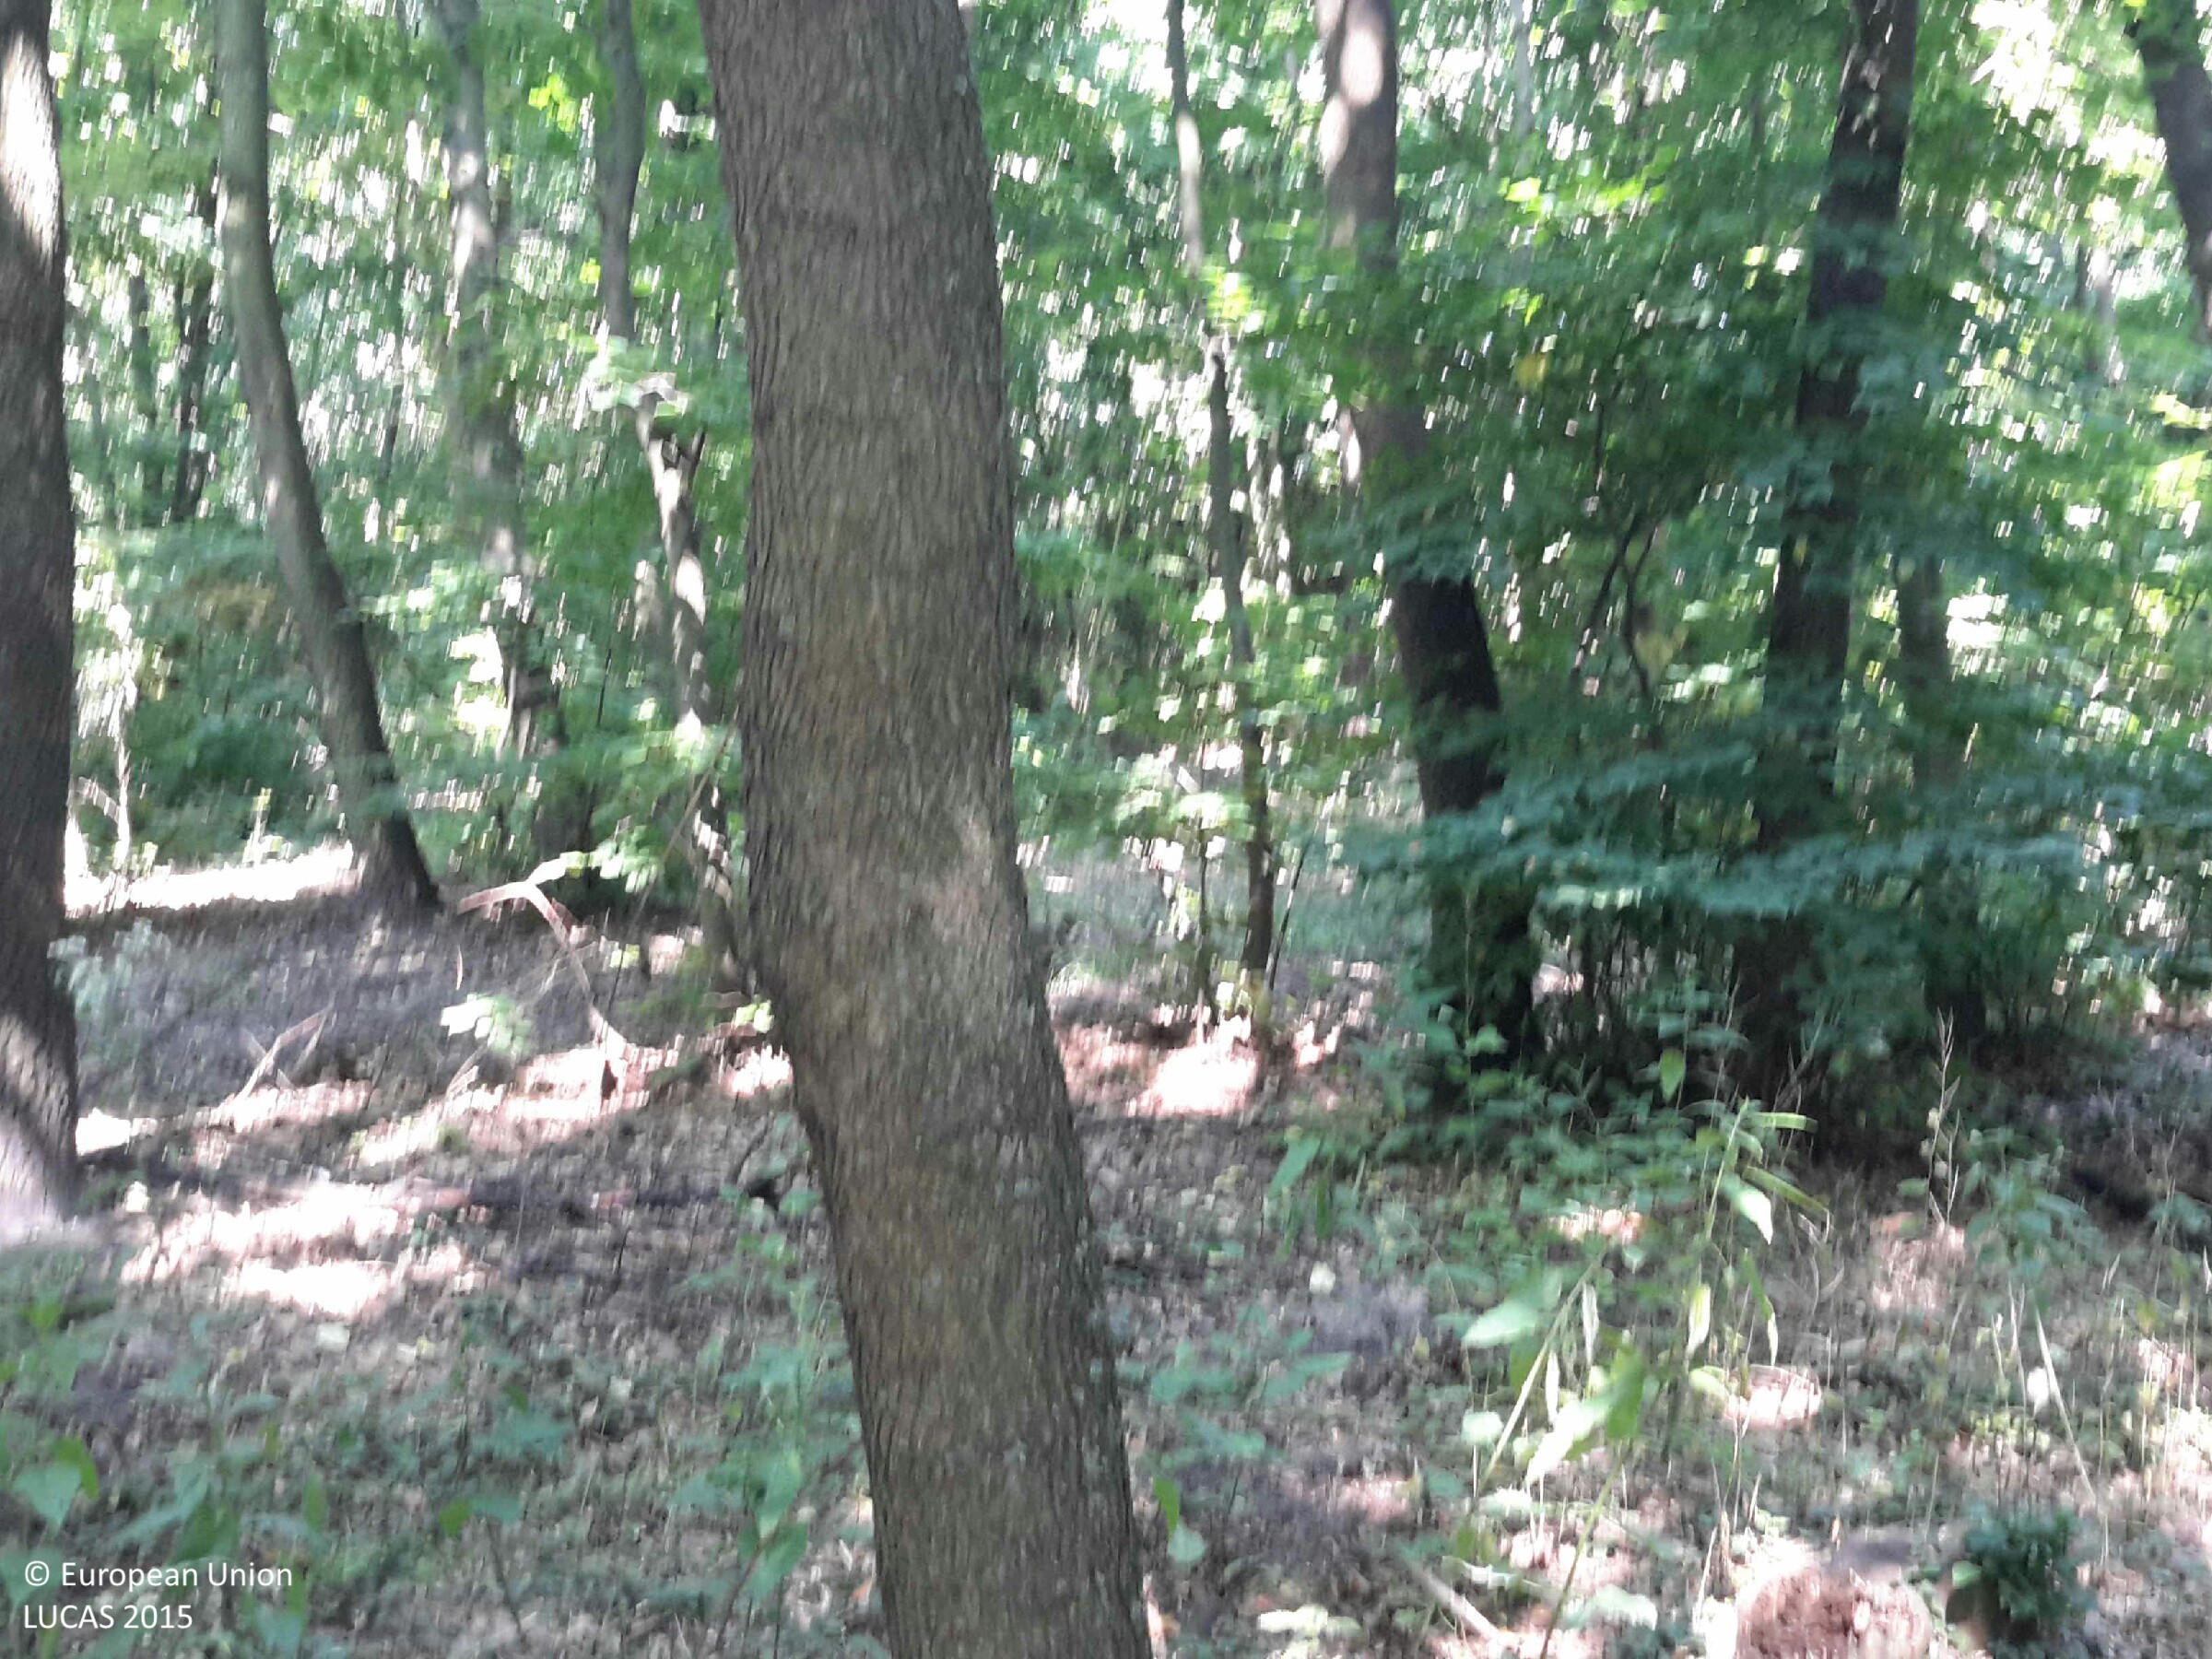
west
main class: Woodland
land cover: Broadleaved woodland
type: mesophytic deciduous forest
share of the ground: > 75 %
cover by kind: broadleaved forest trees 80 %, shrubs 10 %, herbaceous plants 10 %
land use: Forestry
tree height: > 5 m
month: June
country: HU
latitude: 47.2308
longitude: 17.4431
